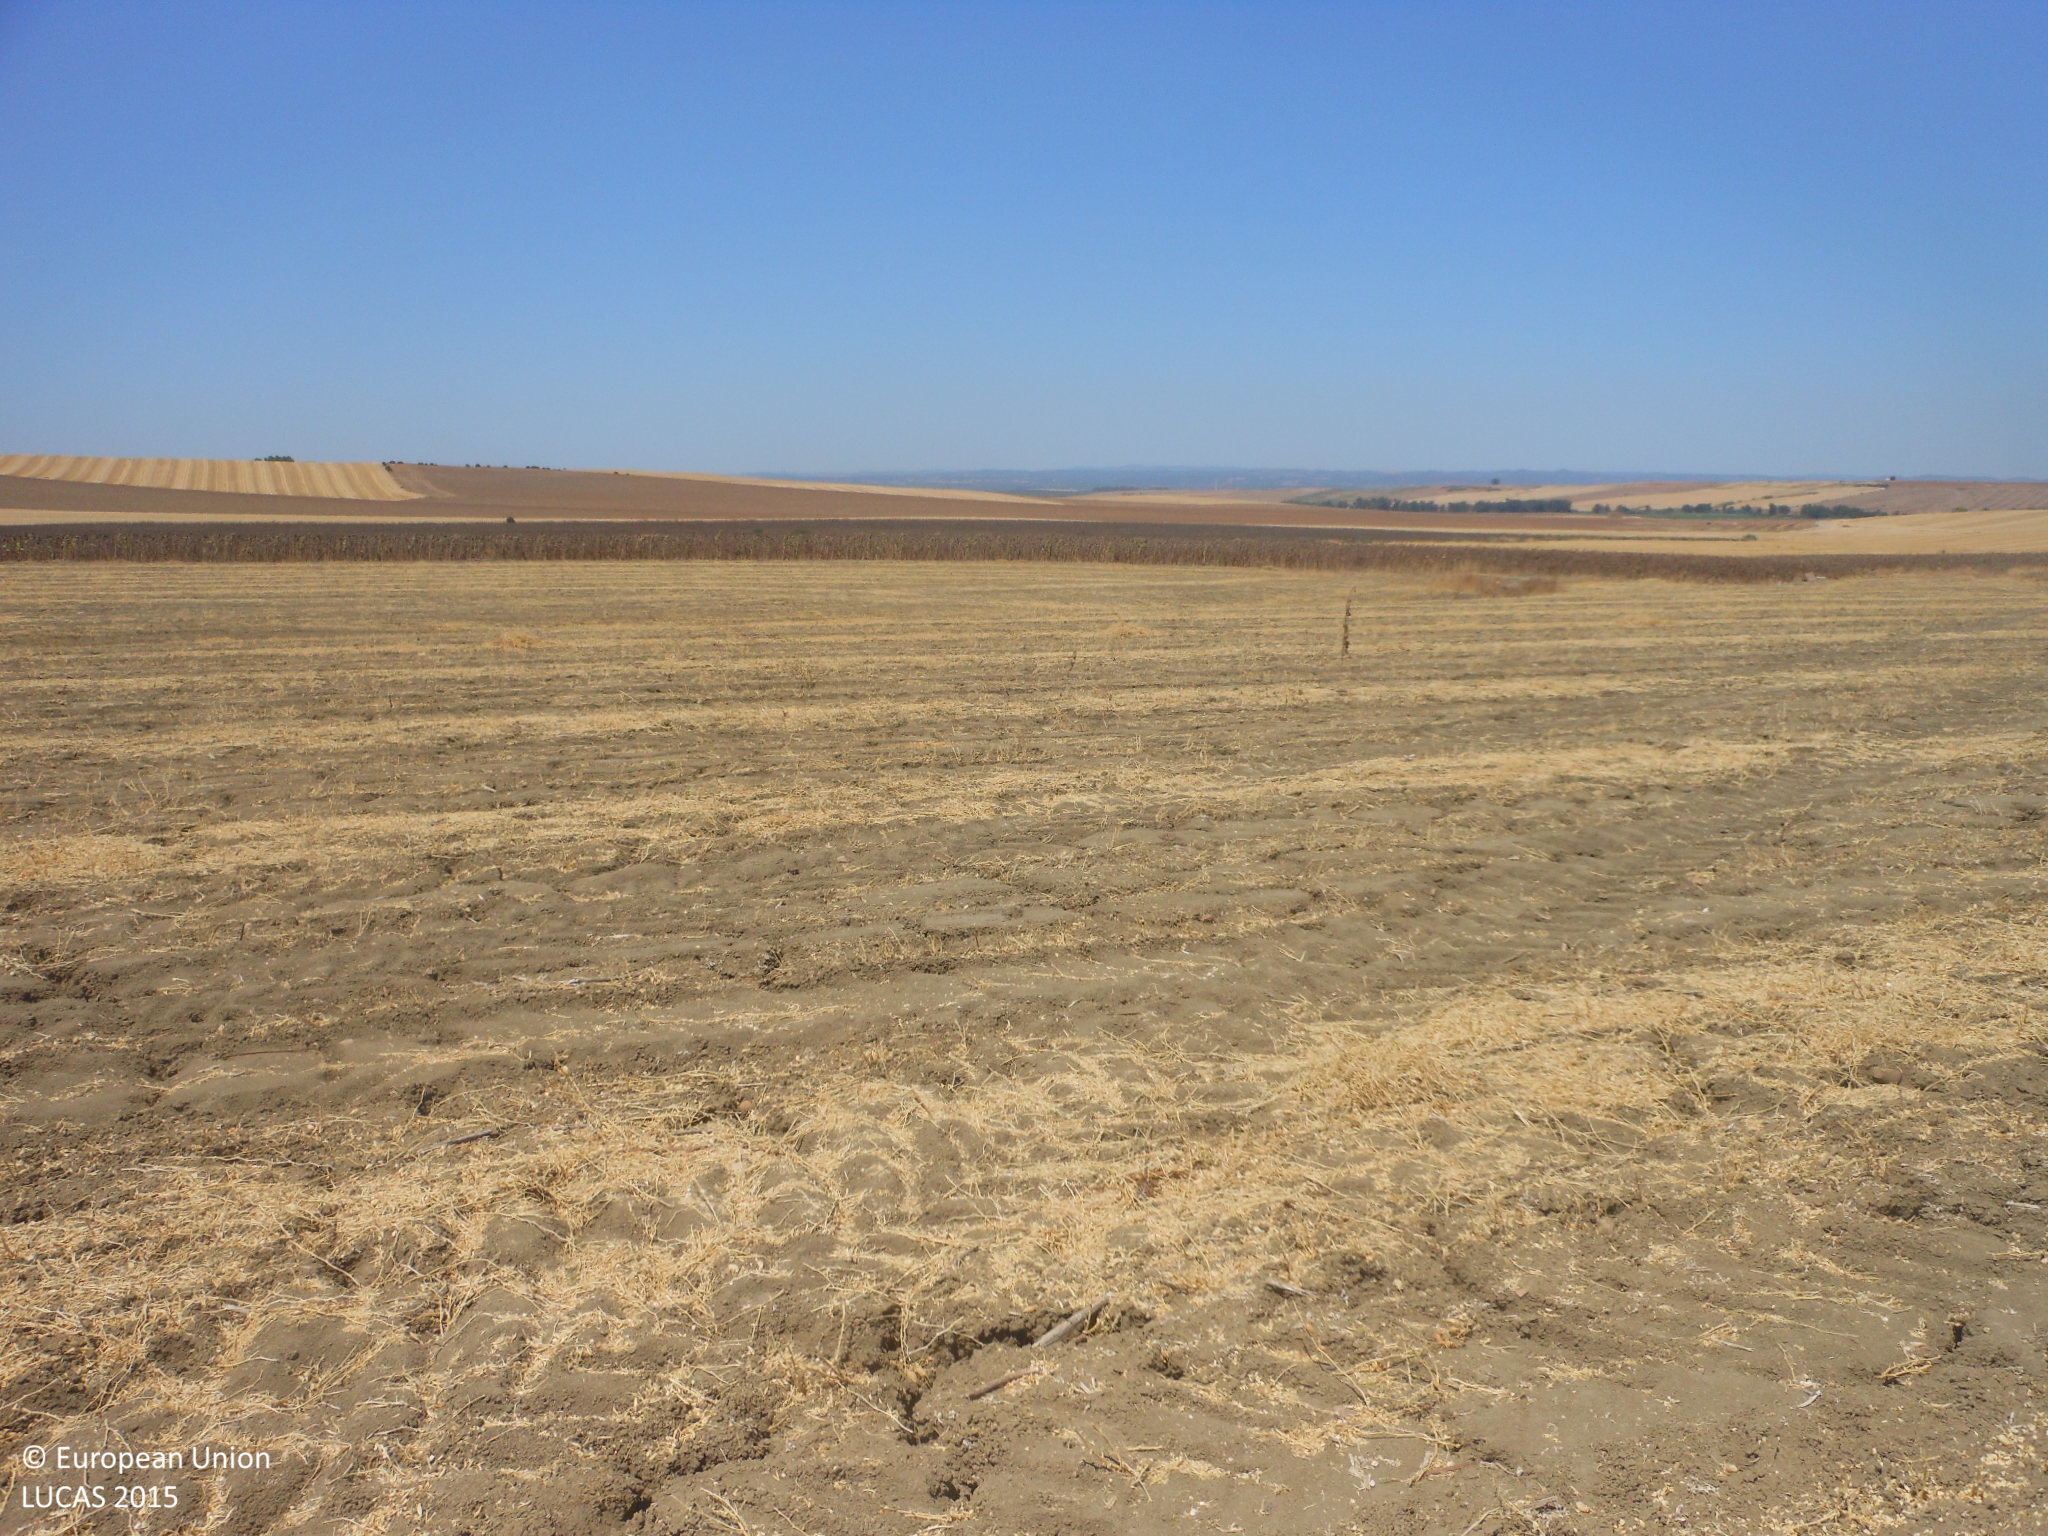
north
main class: Cropland
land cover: Dry pulses
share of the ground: < 10 %
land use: Agriculture (excluding fallow land and kitchen gardens)
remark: Harvested field
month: July
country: ES
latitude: 37.5201
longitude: -5.6000
